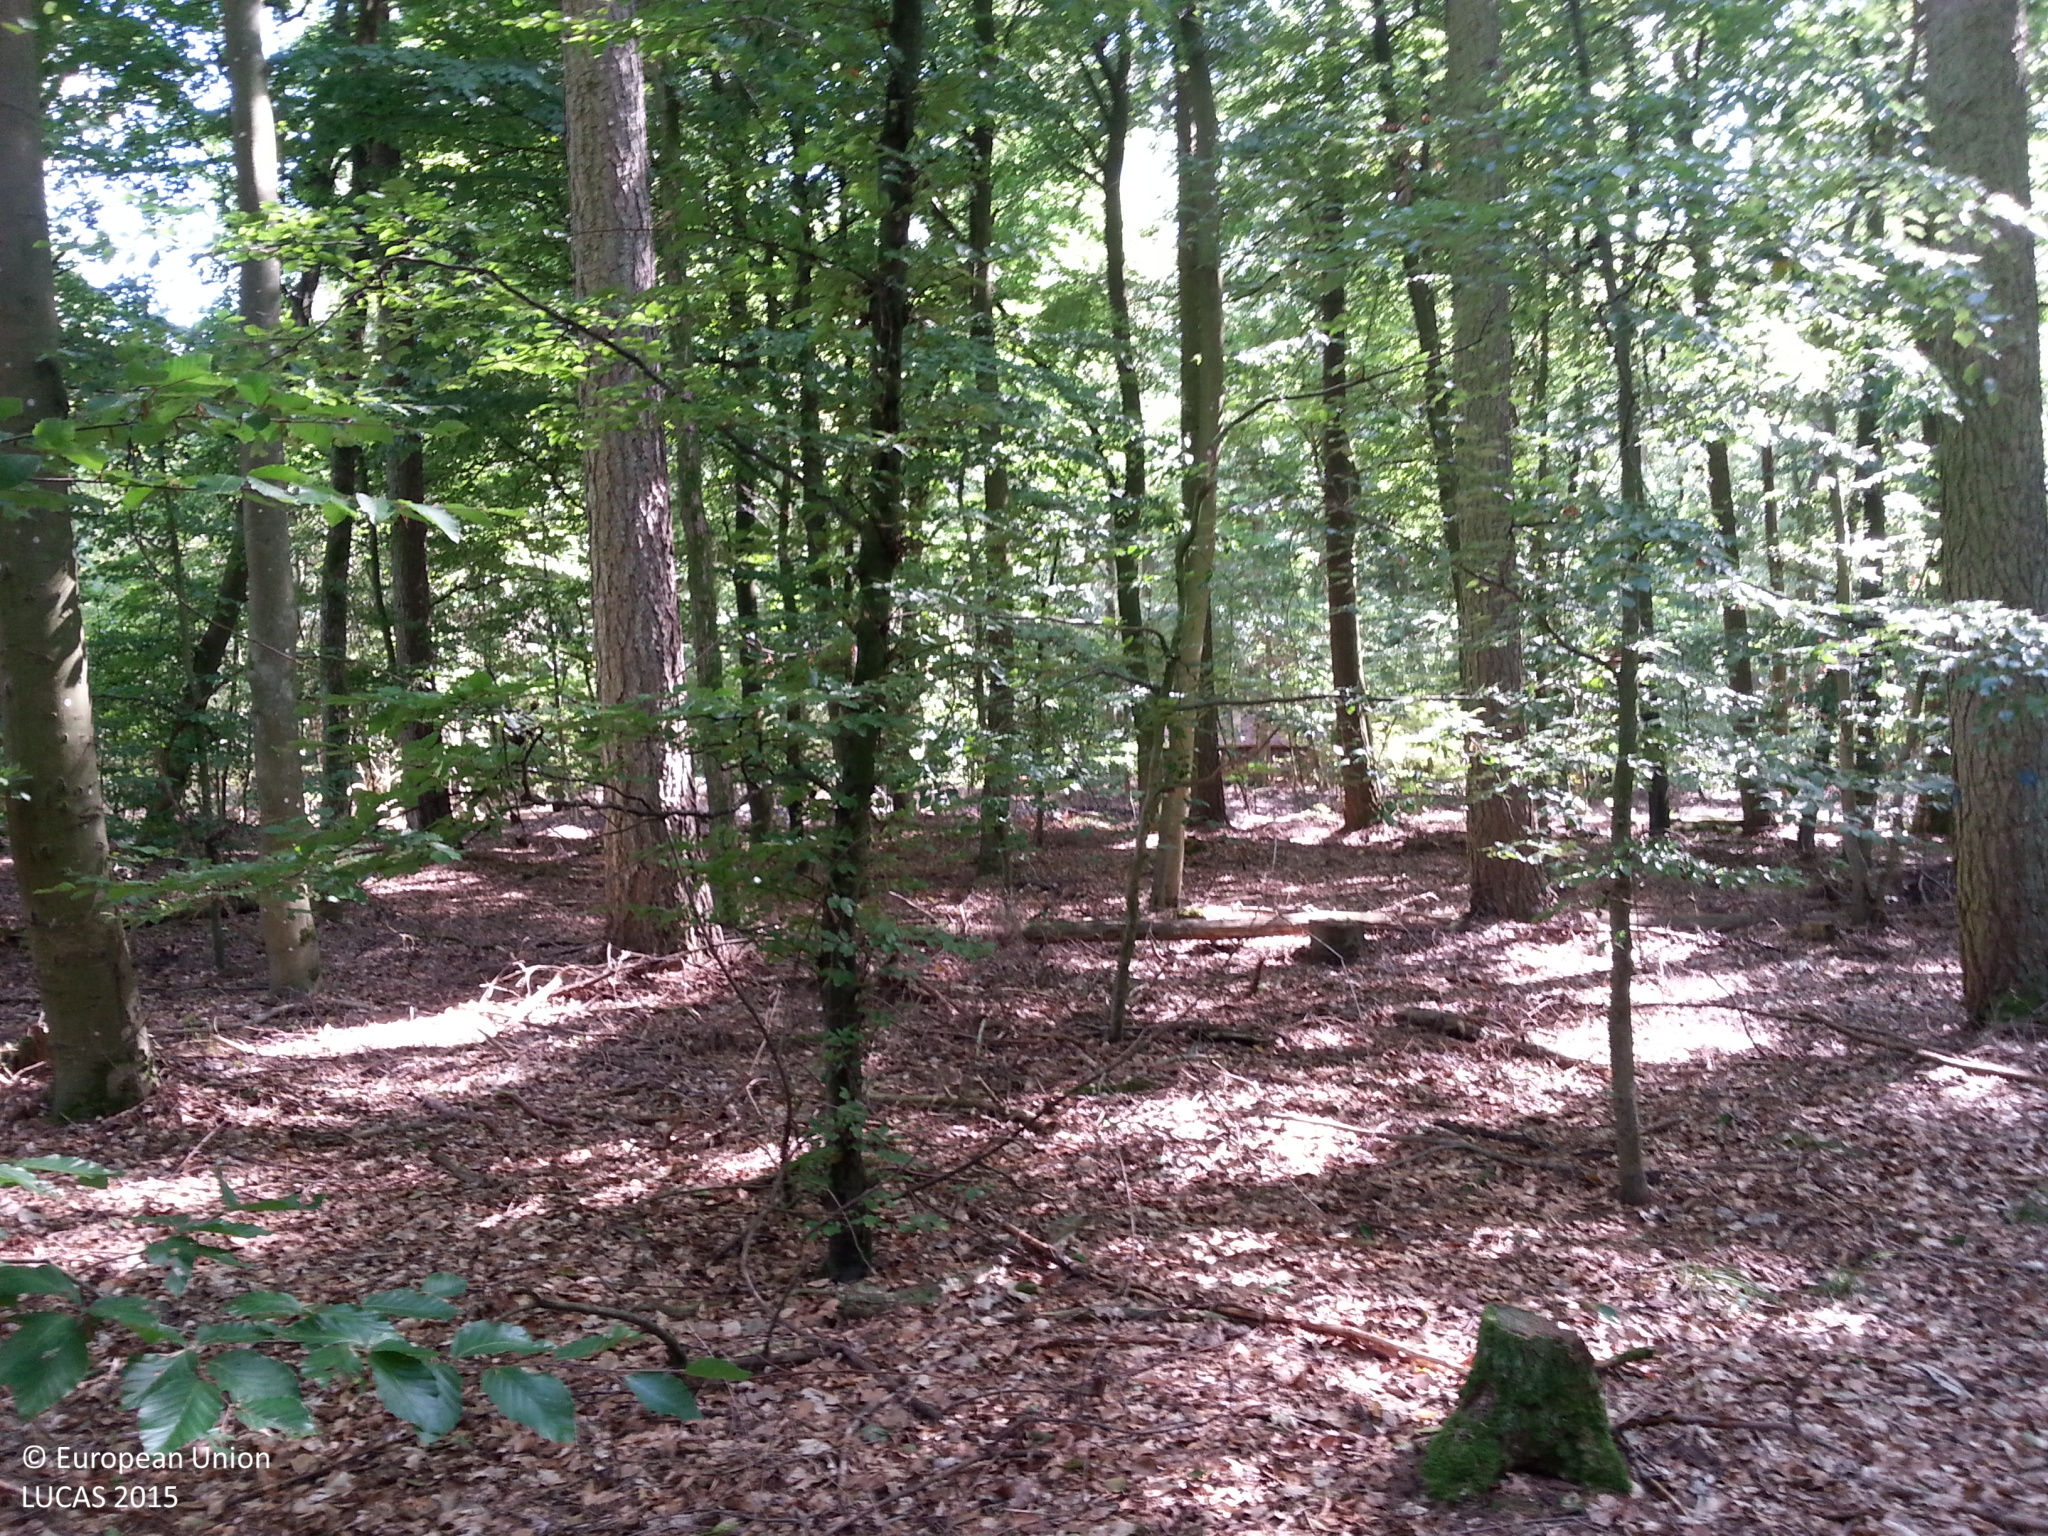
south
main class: Woodland
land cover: Other mixed woodland
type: hemiboreal forest and nemoral coniferous forest and mixed broadleaved-coniferous forest
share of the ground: > 75 %
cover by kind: broadleaved forest trees 50 %, coniferous forest trees 40 %, unconsolidated bare surface 10 %
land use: Forestry
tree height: > 5 m
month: August
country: DE
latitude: 49.4649
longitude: 9.9586
